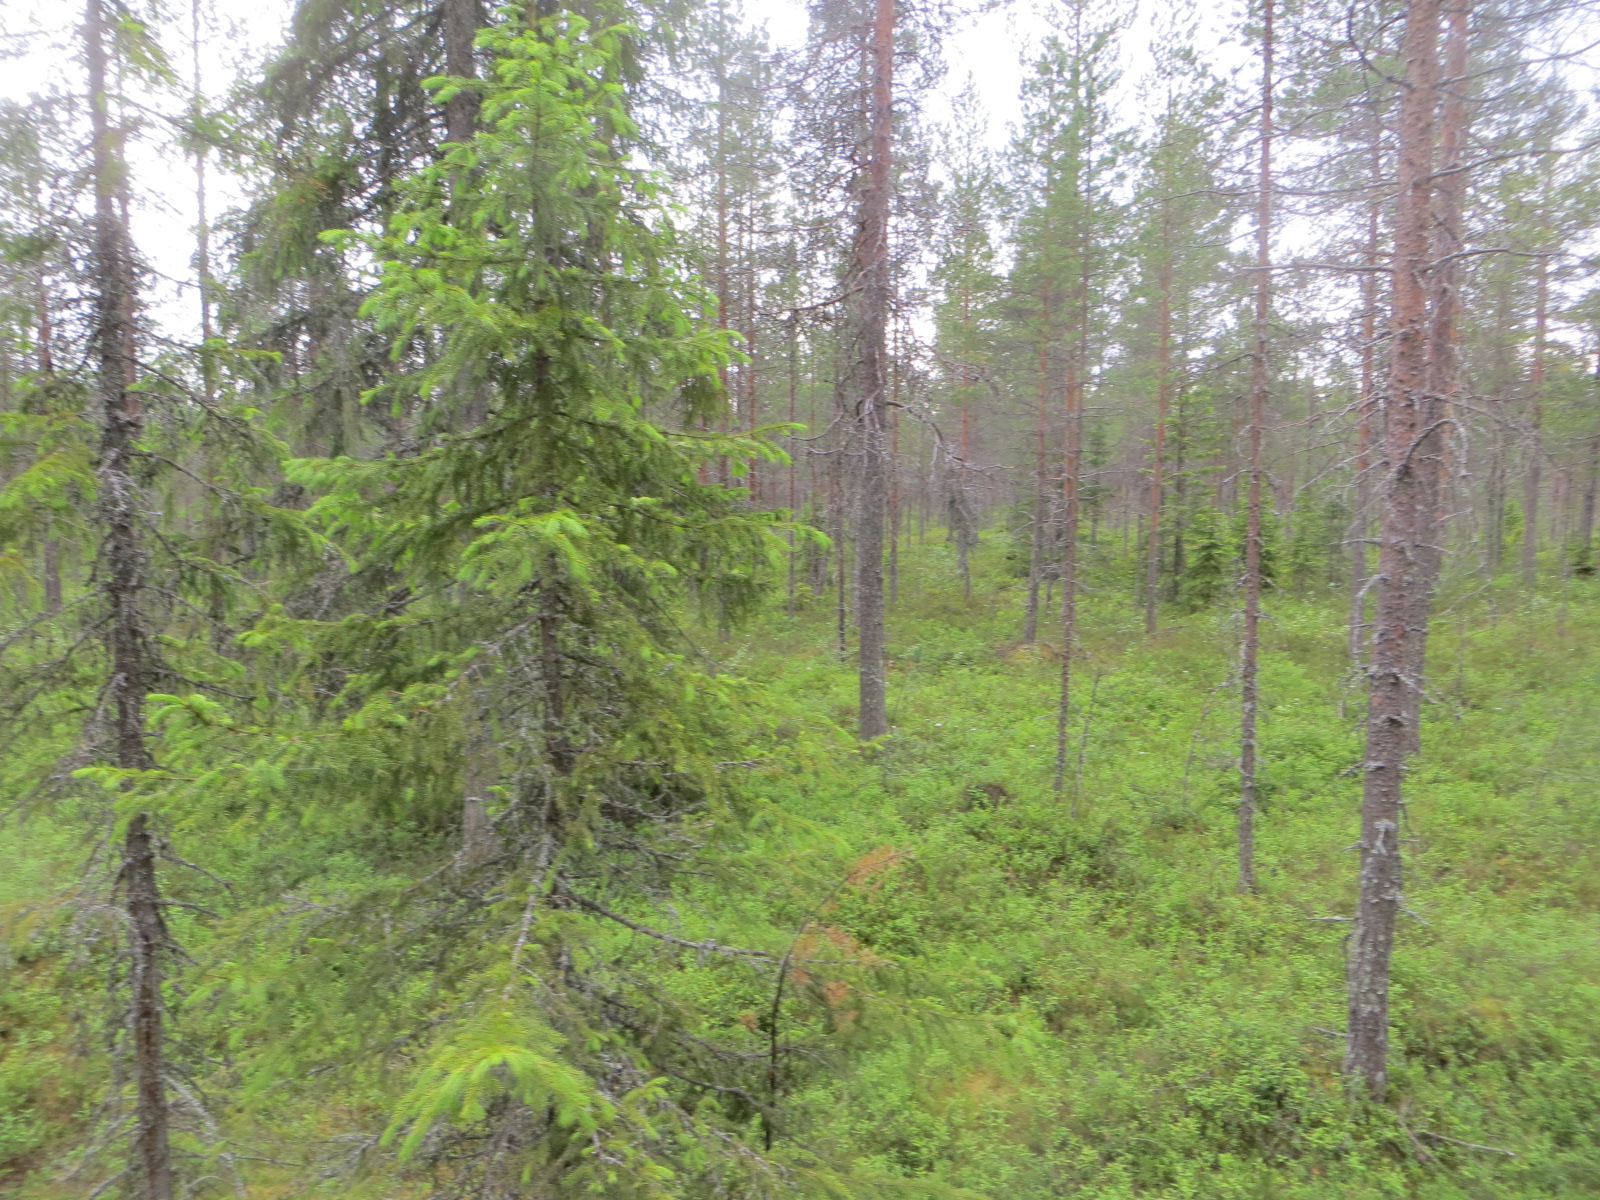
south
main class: Woodland
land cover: Pine dominated coniferous woodland
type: boreal forest
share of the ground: > 75 %
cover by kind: coniferous forest trees 75 %, shrubs 20 %, lichens and mosses 5 %
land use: Forestry
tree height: > 5 m
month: June
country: FI
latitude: 65.6194
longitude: 26.8923
